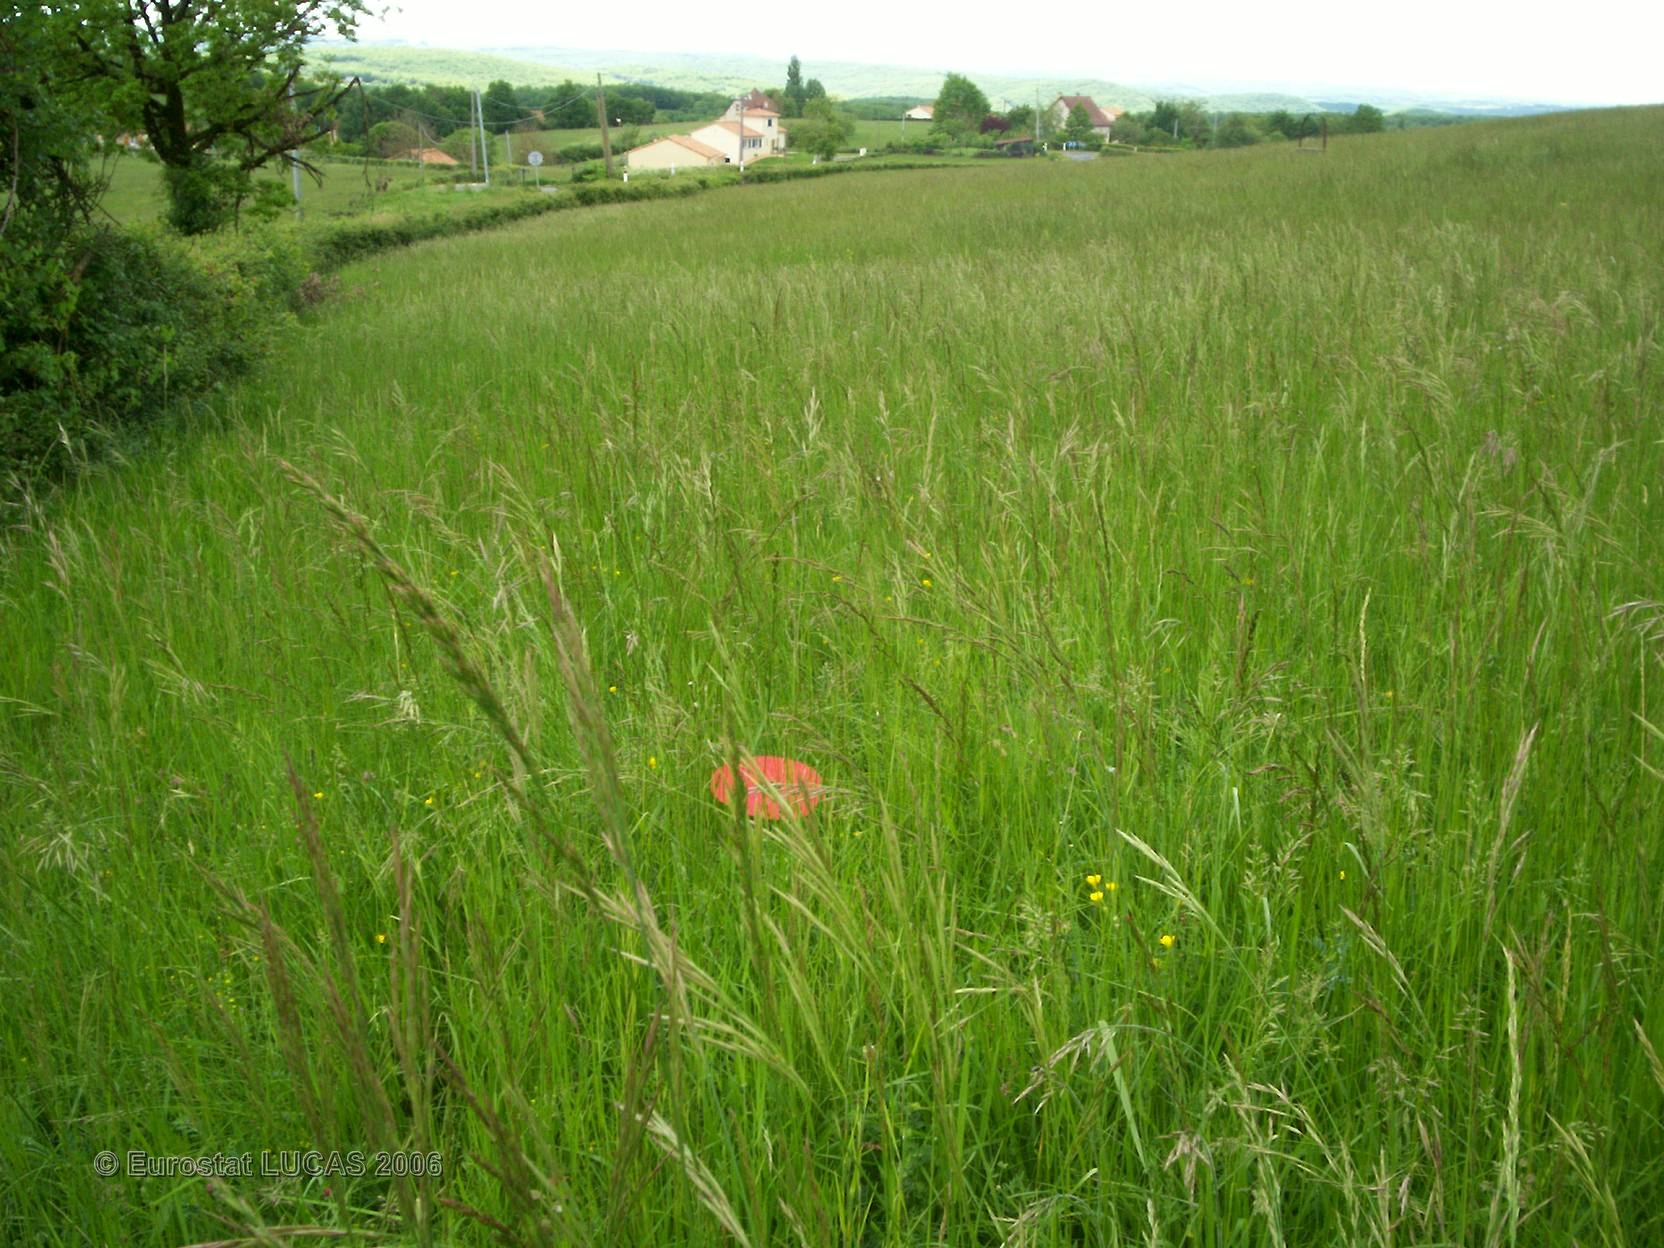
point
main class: Grassland
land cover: Grassland without tree/shrub cover
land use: Agriculture (excluding fallow land and kitchen gardens)
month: May
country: FR
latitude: 45.1096
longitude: 1.3133
